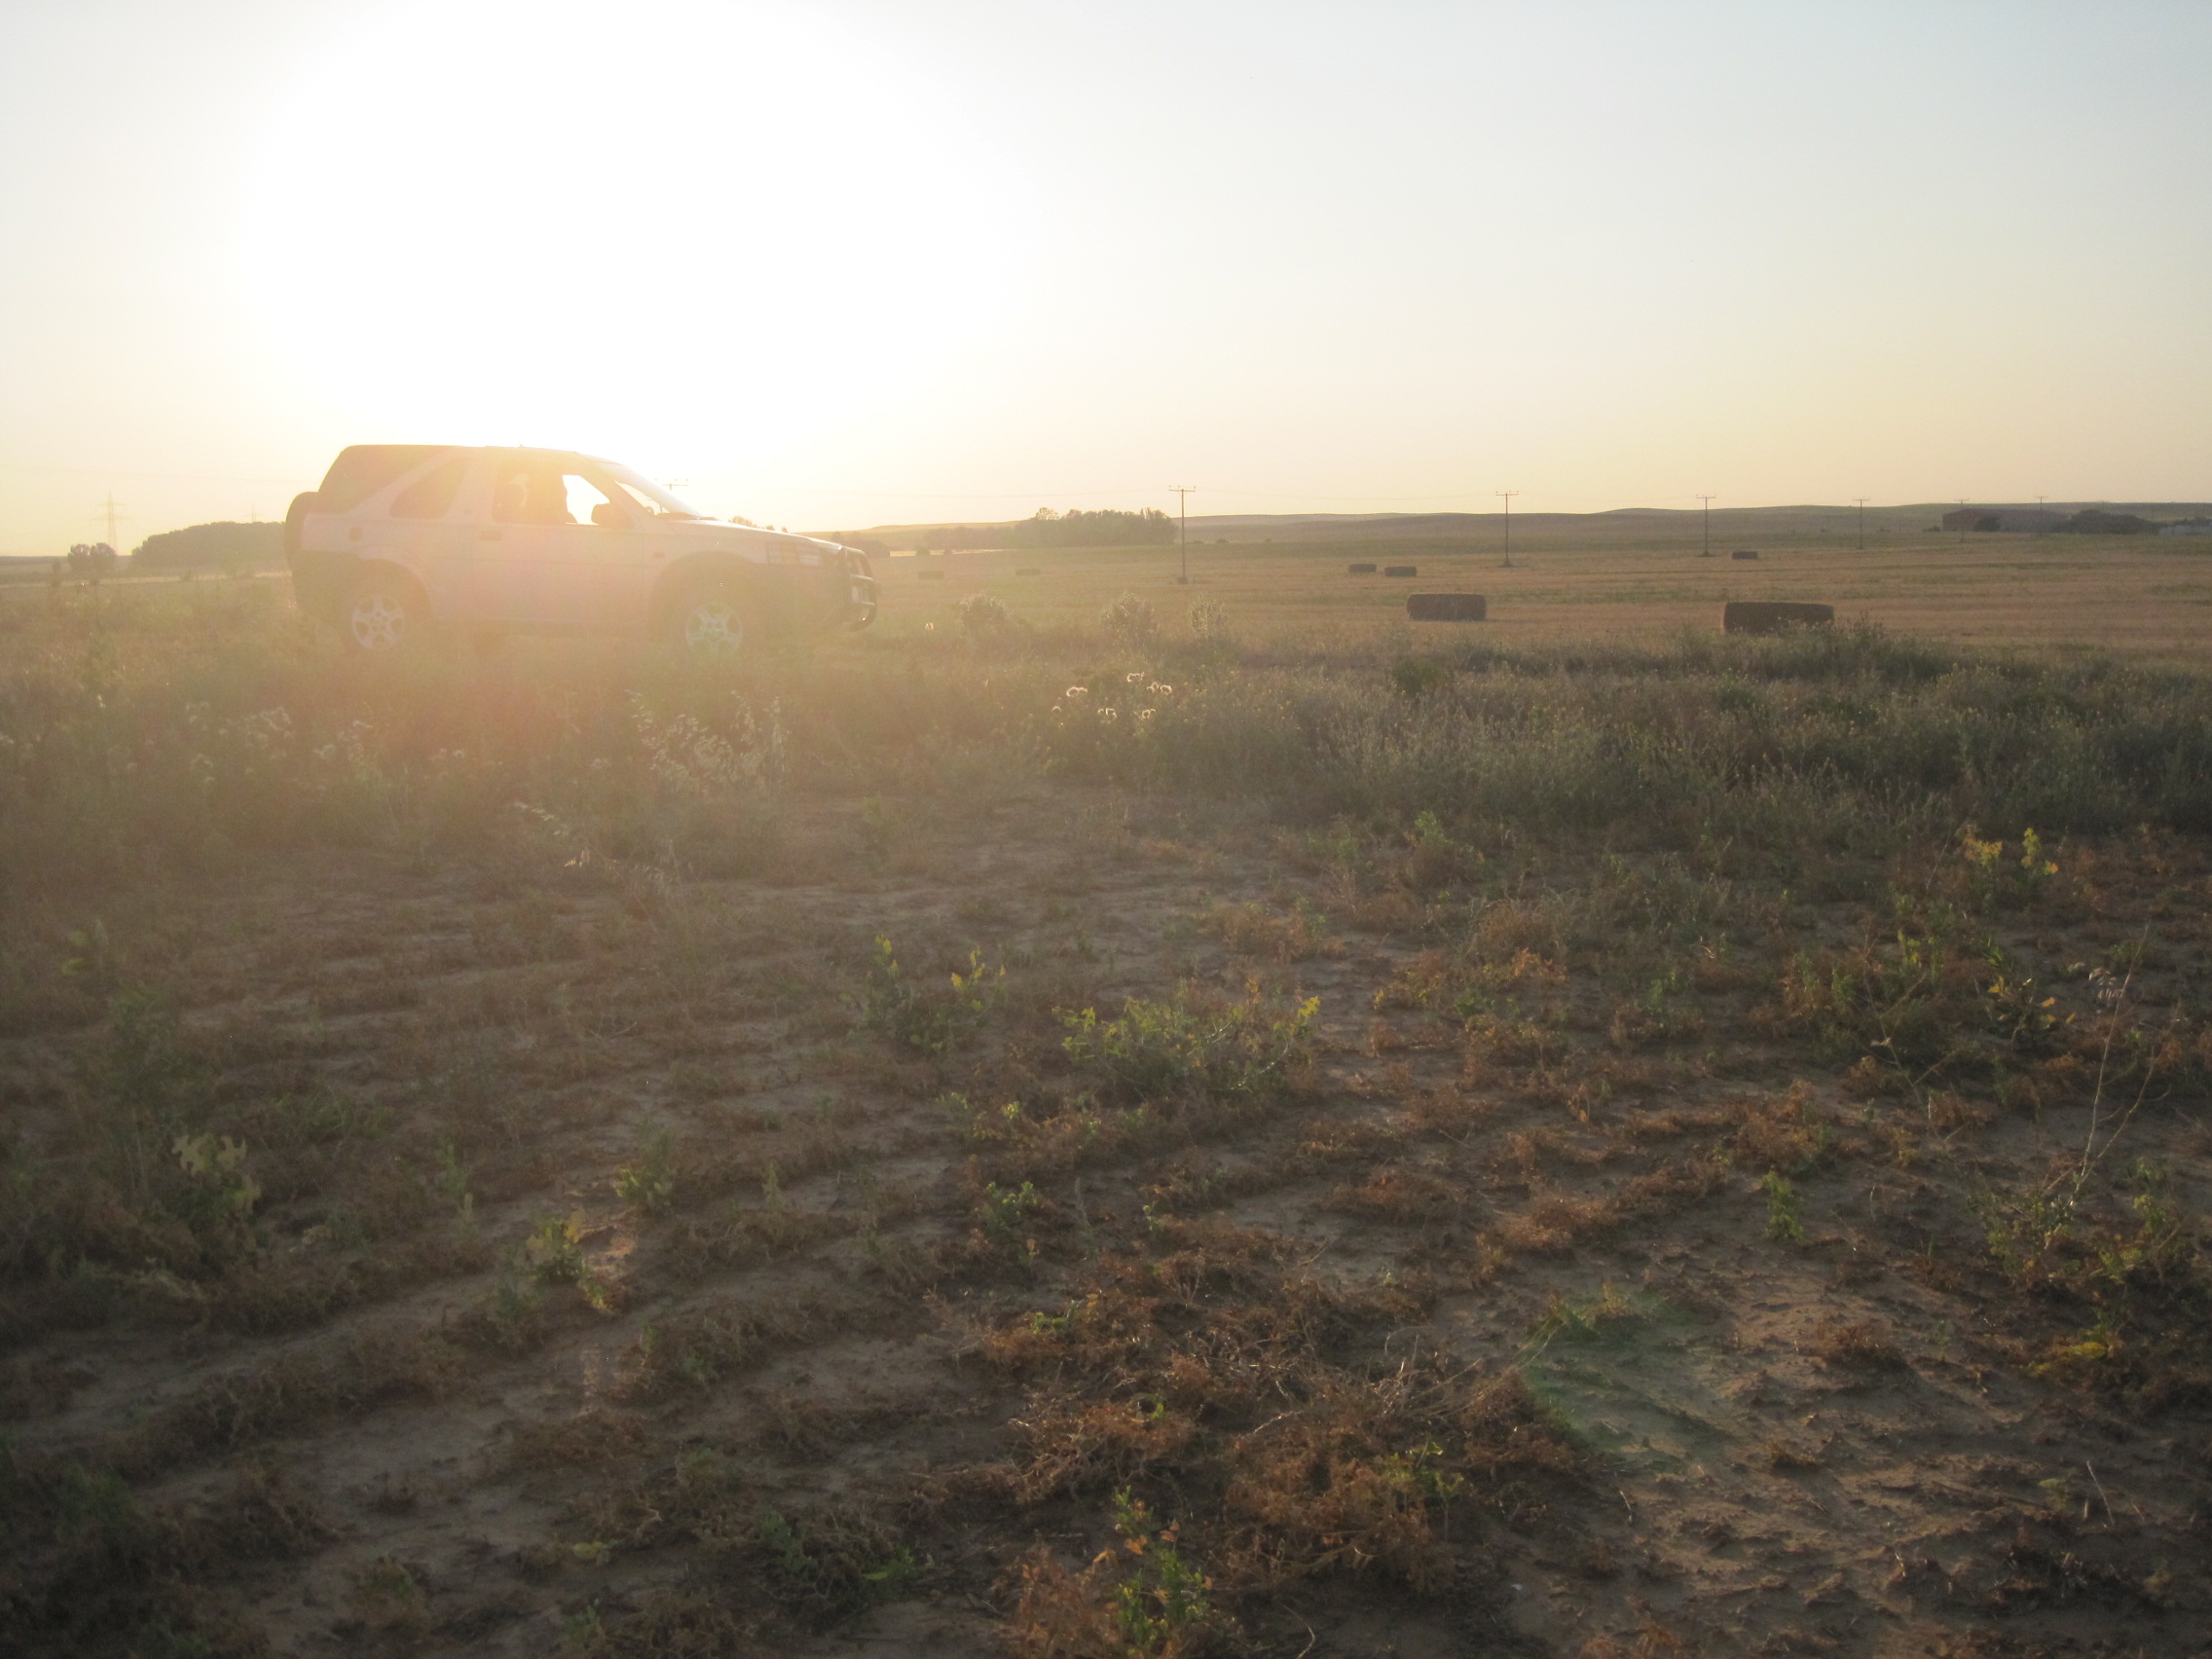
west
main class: Cropland
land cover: Dry pulses
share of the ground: 25 - 50 %
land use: Agriculture (excluding fallow land and kitchen gardens)
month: July
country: ES
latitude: 41.8909
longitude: -5.1574
